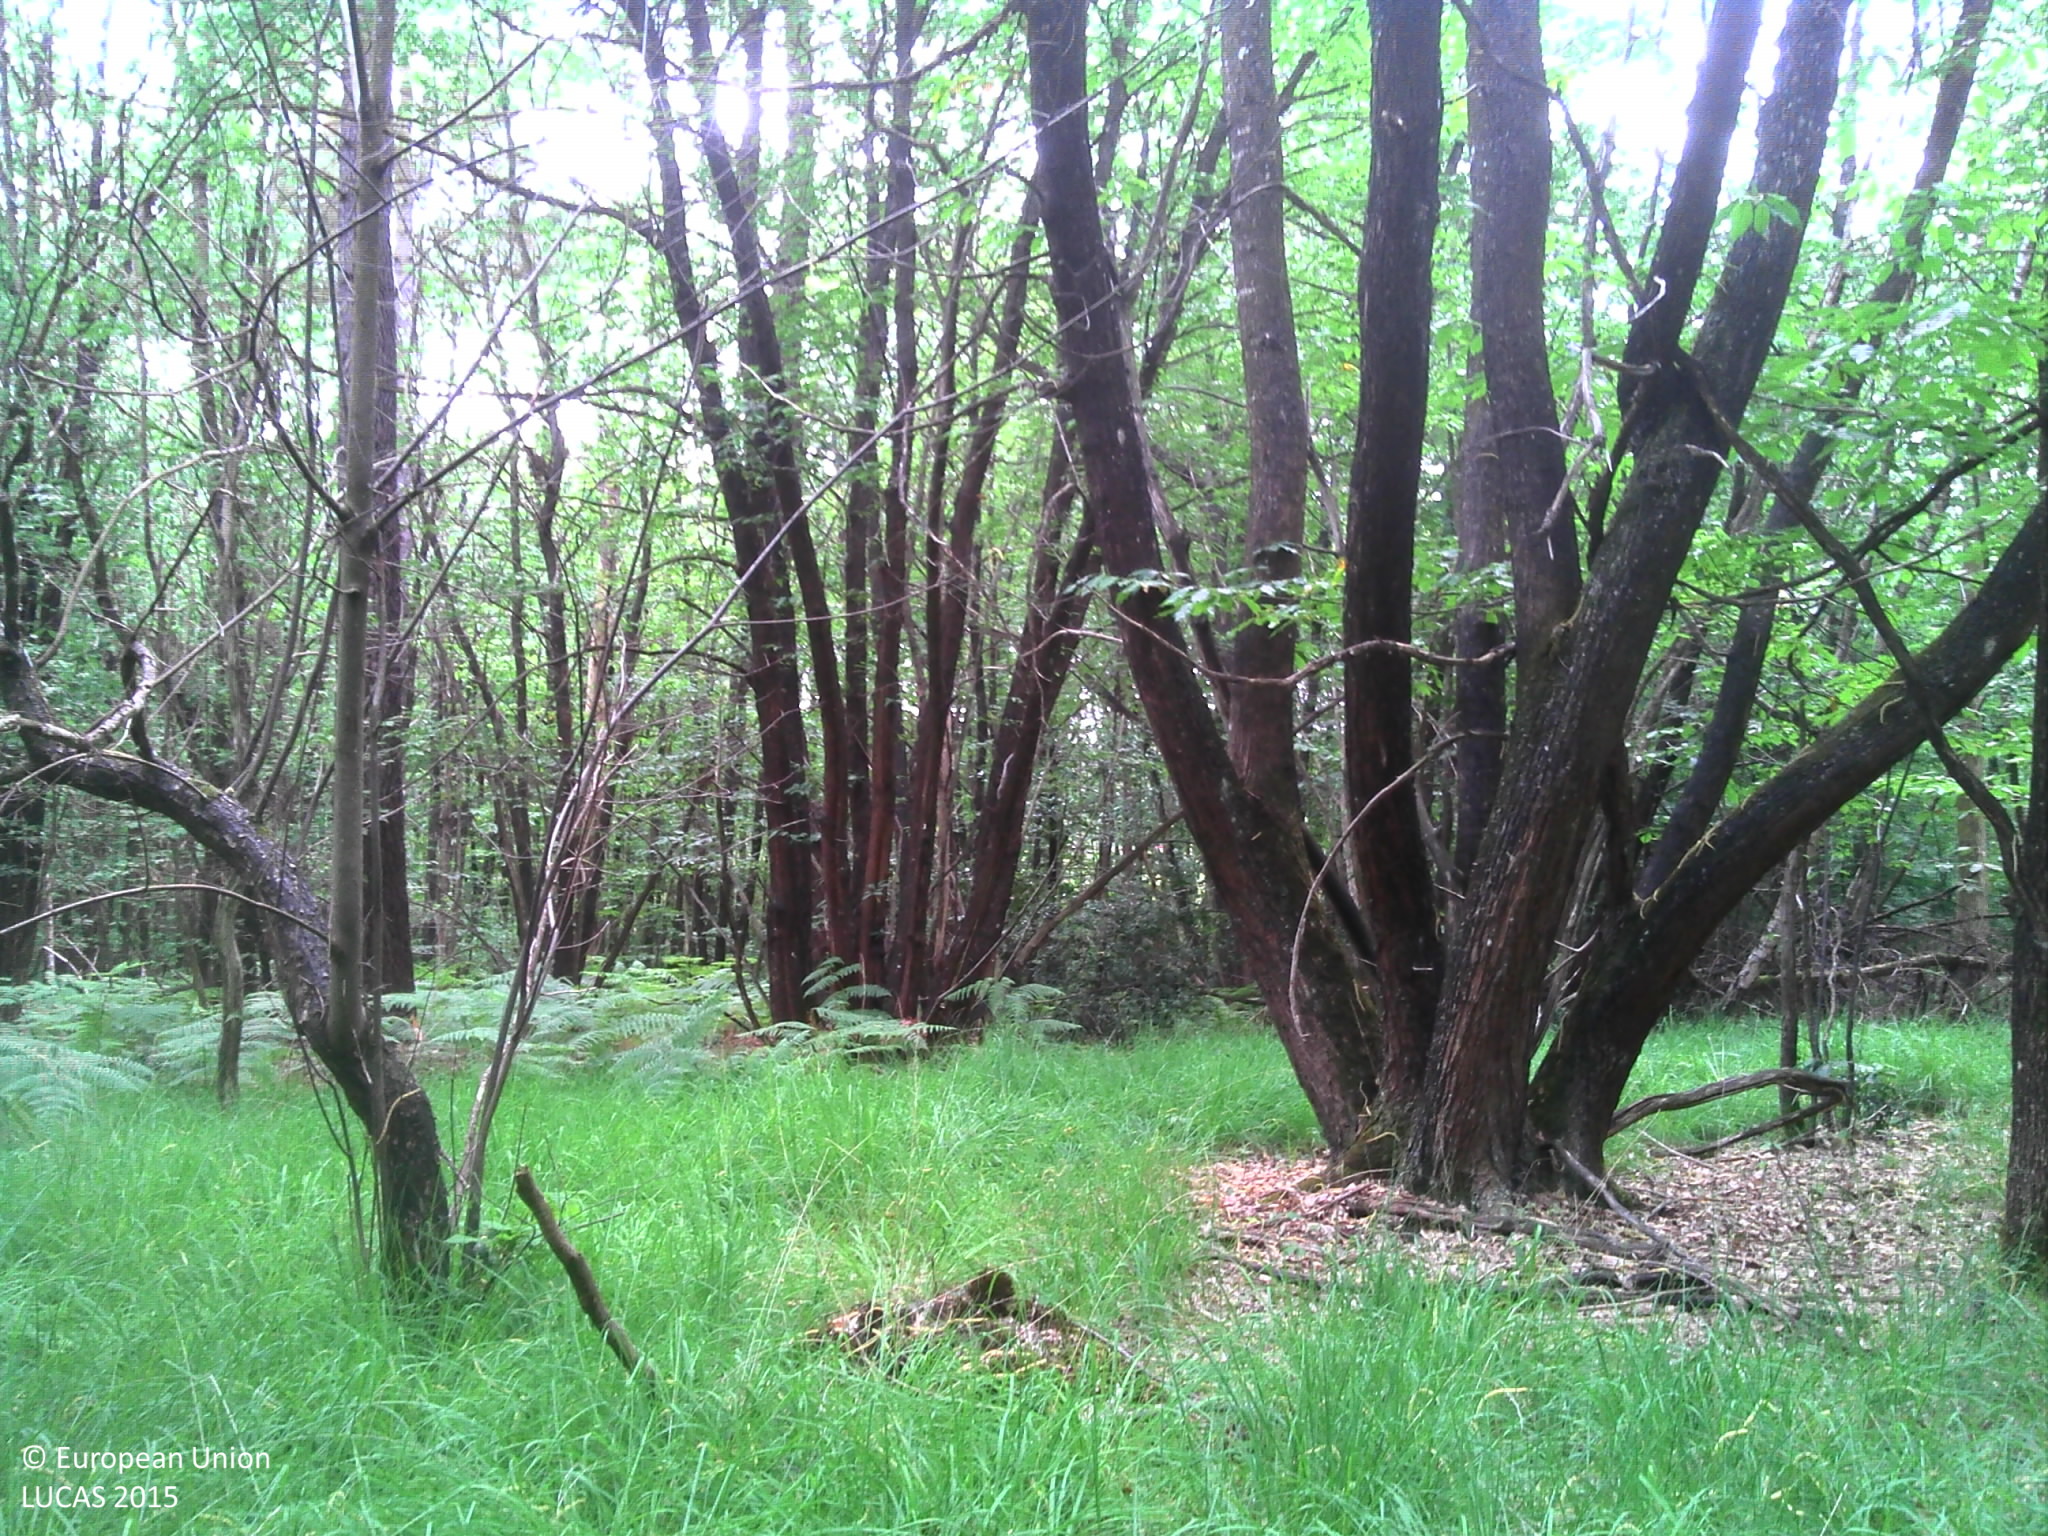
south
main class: Woodland
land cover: Pine dominated mixed woodland
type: acidophilous oak and oak-birch forest
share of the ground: > 75 %
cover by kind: broadleaved forest trees 40 %, coniferous forest trees 30 %, herbaceous plants 20 %, shrubs 5 %, lichens and mosses 5 %
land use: Forestry
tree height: > 5 m
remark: Fire break
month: July
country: FR
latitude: 47.3099
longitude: 0.1480
